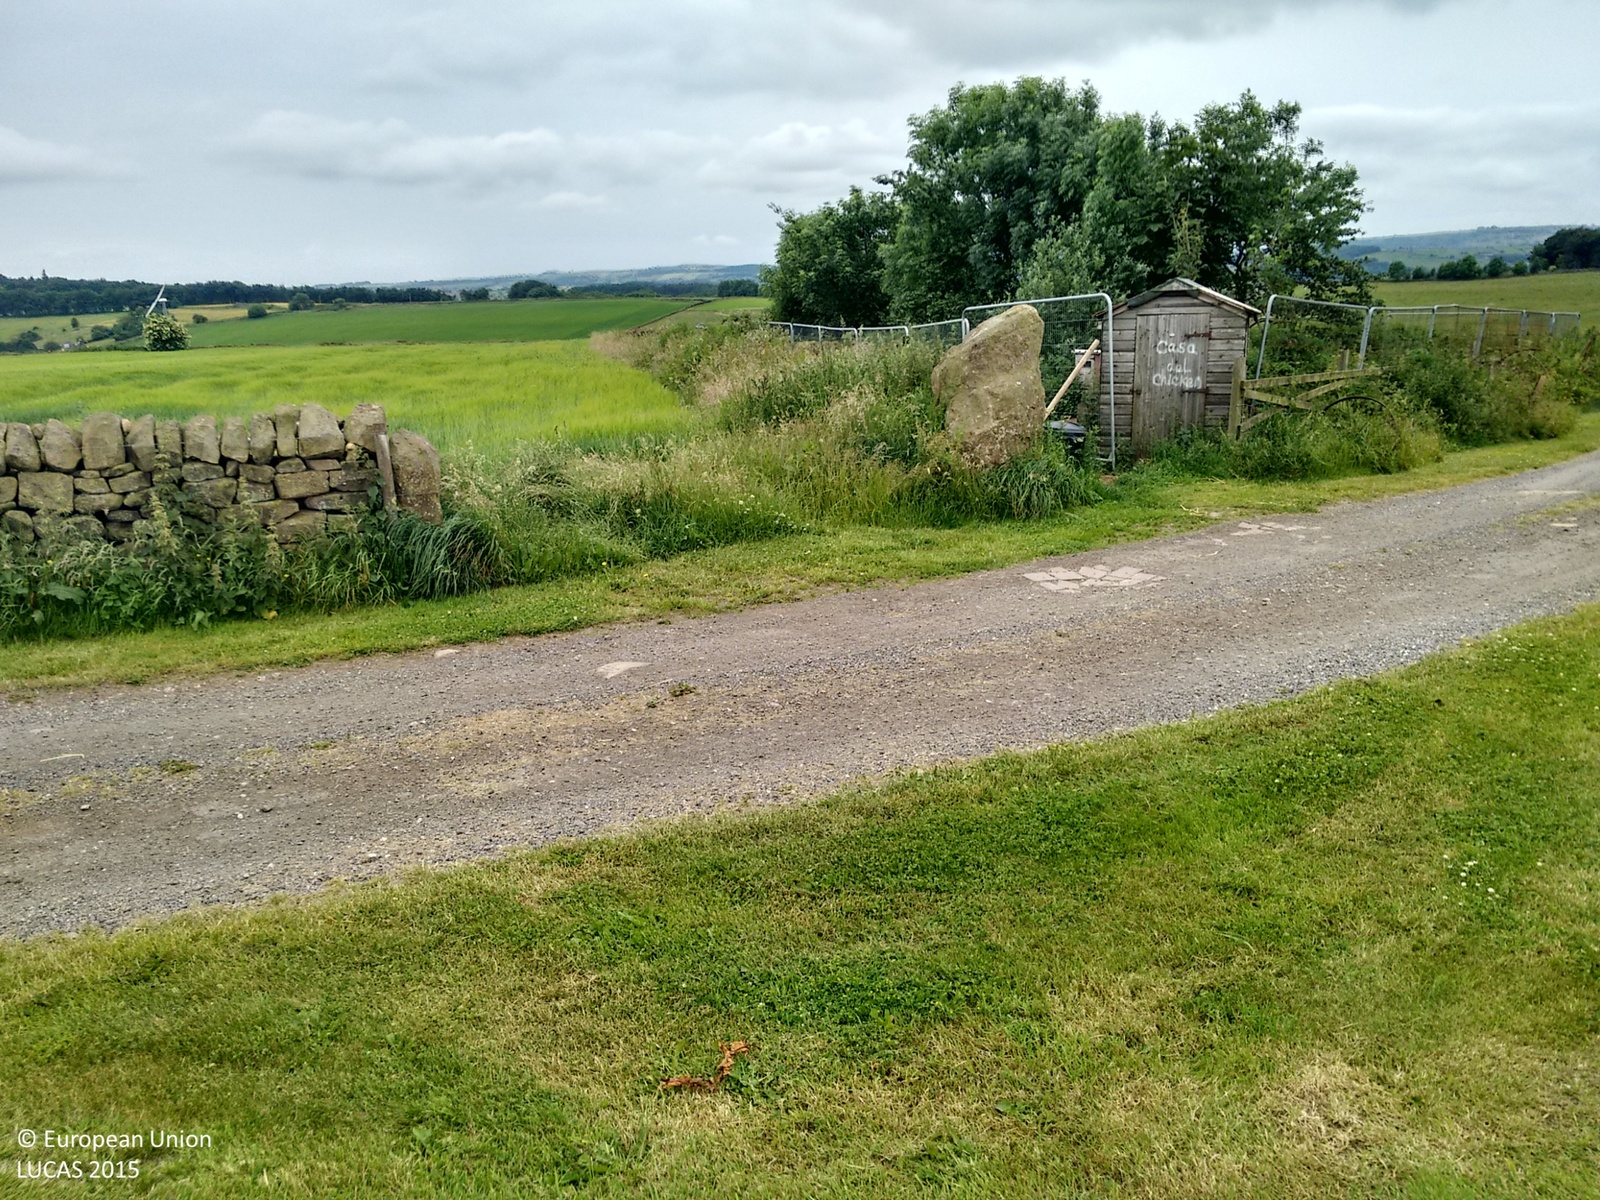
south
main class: Cropland
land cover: Barley
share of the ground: > 75 %
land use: Agriculture (excluding fallow land and kitchen gardens)
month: July
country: GB
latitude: 53.1439
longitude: -1.4873
